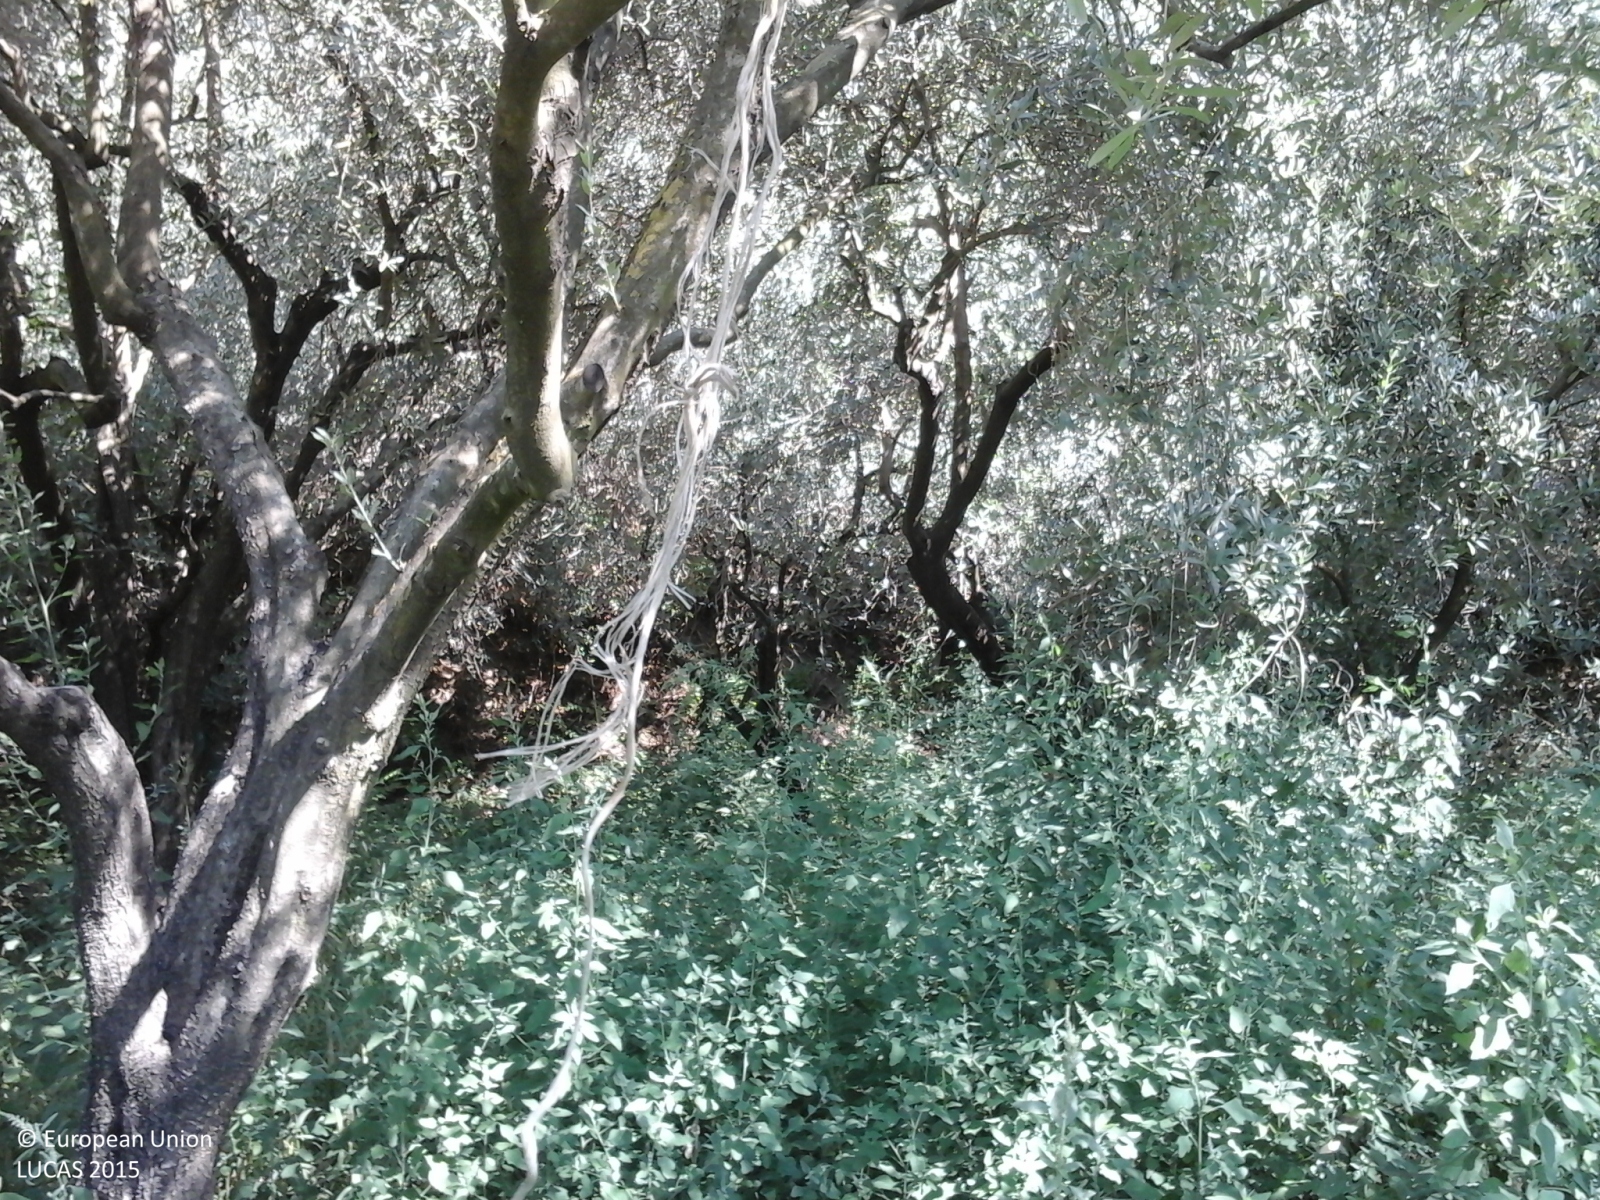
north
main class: Woodland
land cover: Broadleaved woodland
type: exotic forest
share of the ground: > 75 %
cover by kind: broadleaved forest trees 100 %
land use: Semi-natural and natural areas not in use
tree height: > 5 m
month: August
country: IT
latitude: 40.7536
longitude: 14.6829
